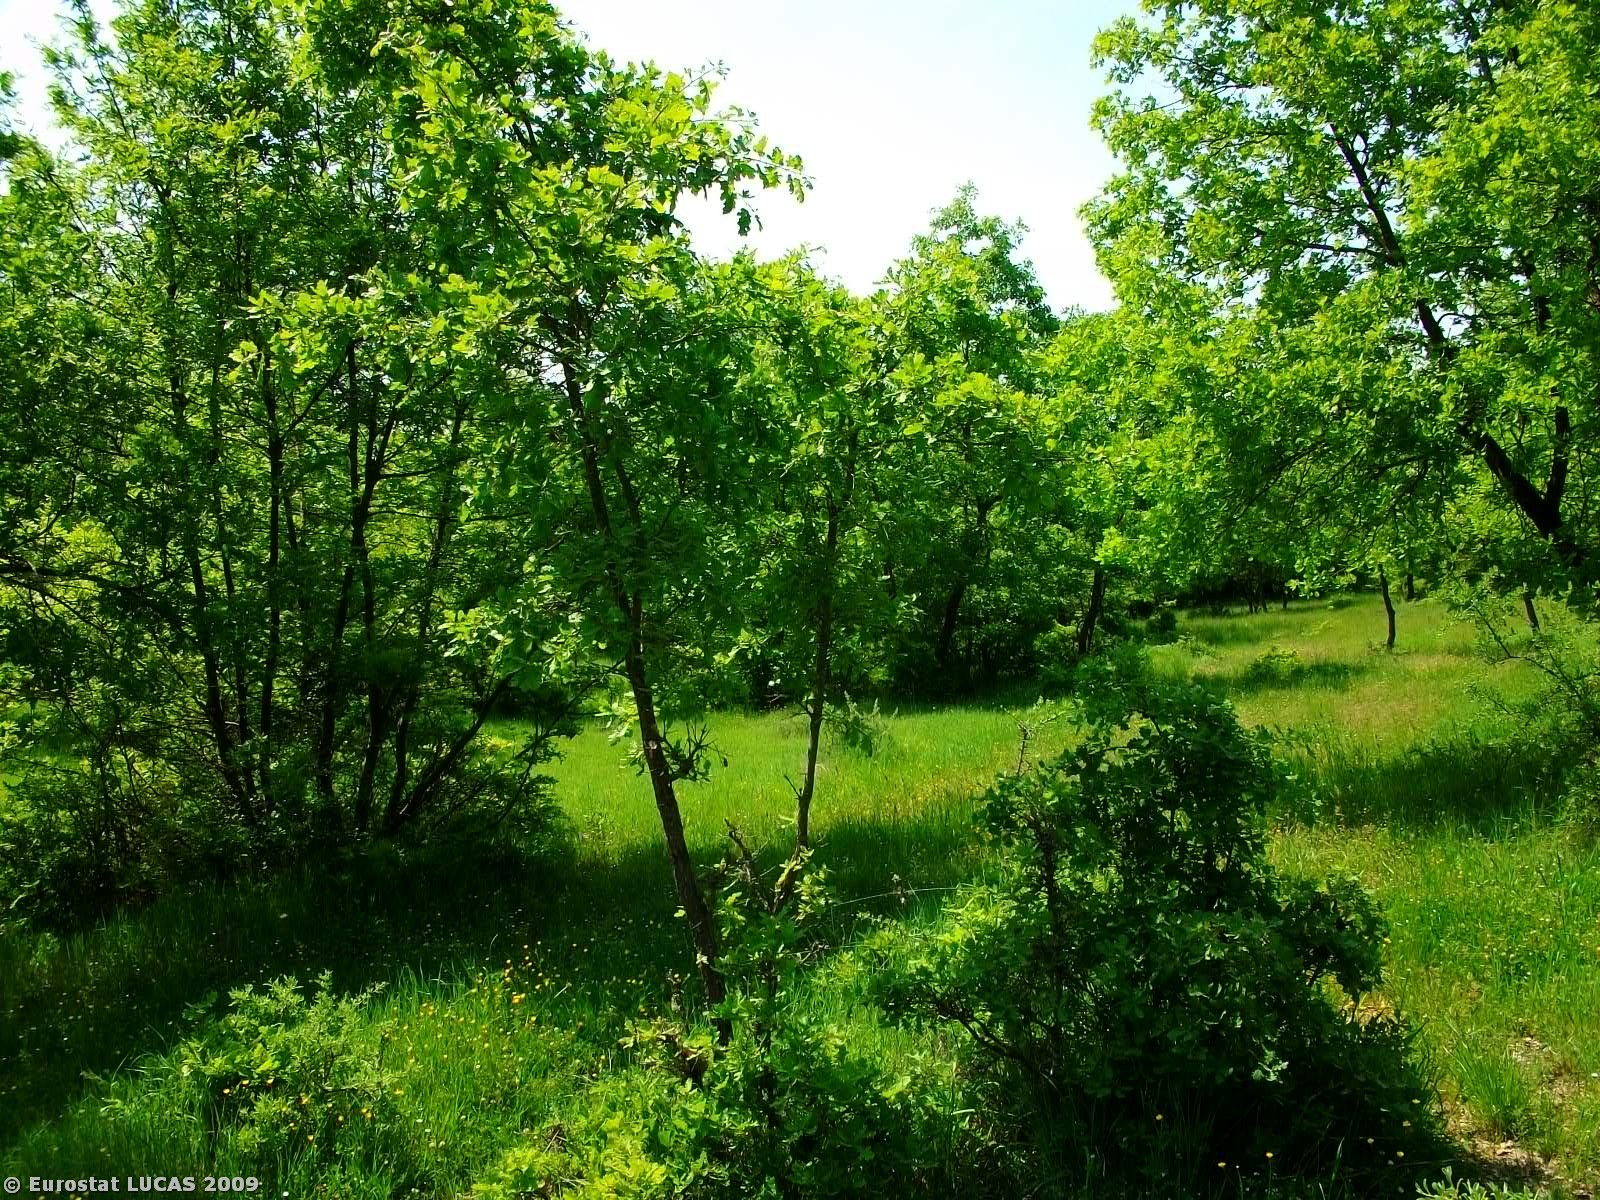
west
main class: Woodland
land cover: Broadleaved woodland
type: thermophilous deciduous forest
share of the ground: 25 - 50 %
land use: Forestry
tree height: > 5 m
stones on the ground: < 10 %
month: May
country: GR
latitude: 39.9149
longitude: 21.6738
